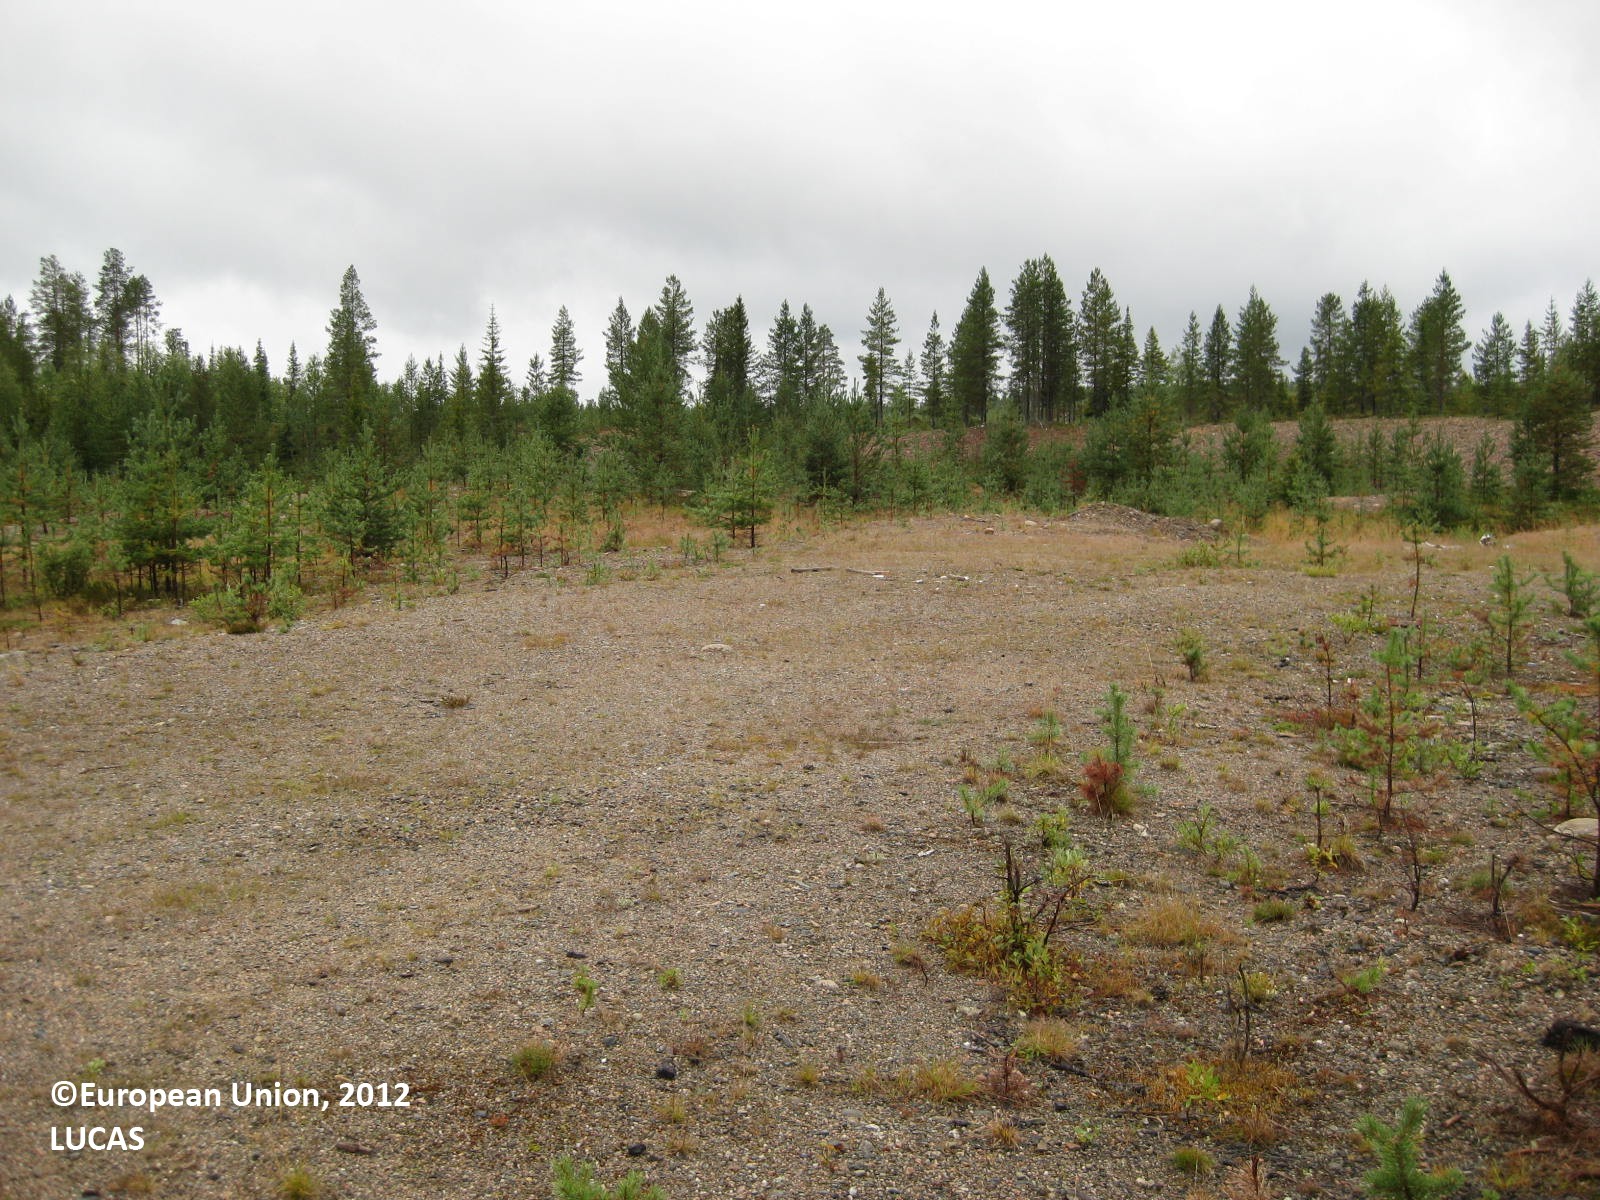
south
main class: Woodland
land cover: Pine dominated coniferous woodland
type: boreal forest
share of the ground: 10 - 25 %
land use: Forestry
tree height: < 5 m
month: August
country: FI
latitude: 66.1445
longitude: 28.4301
